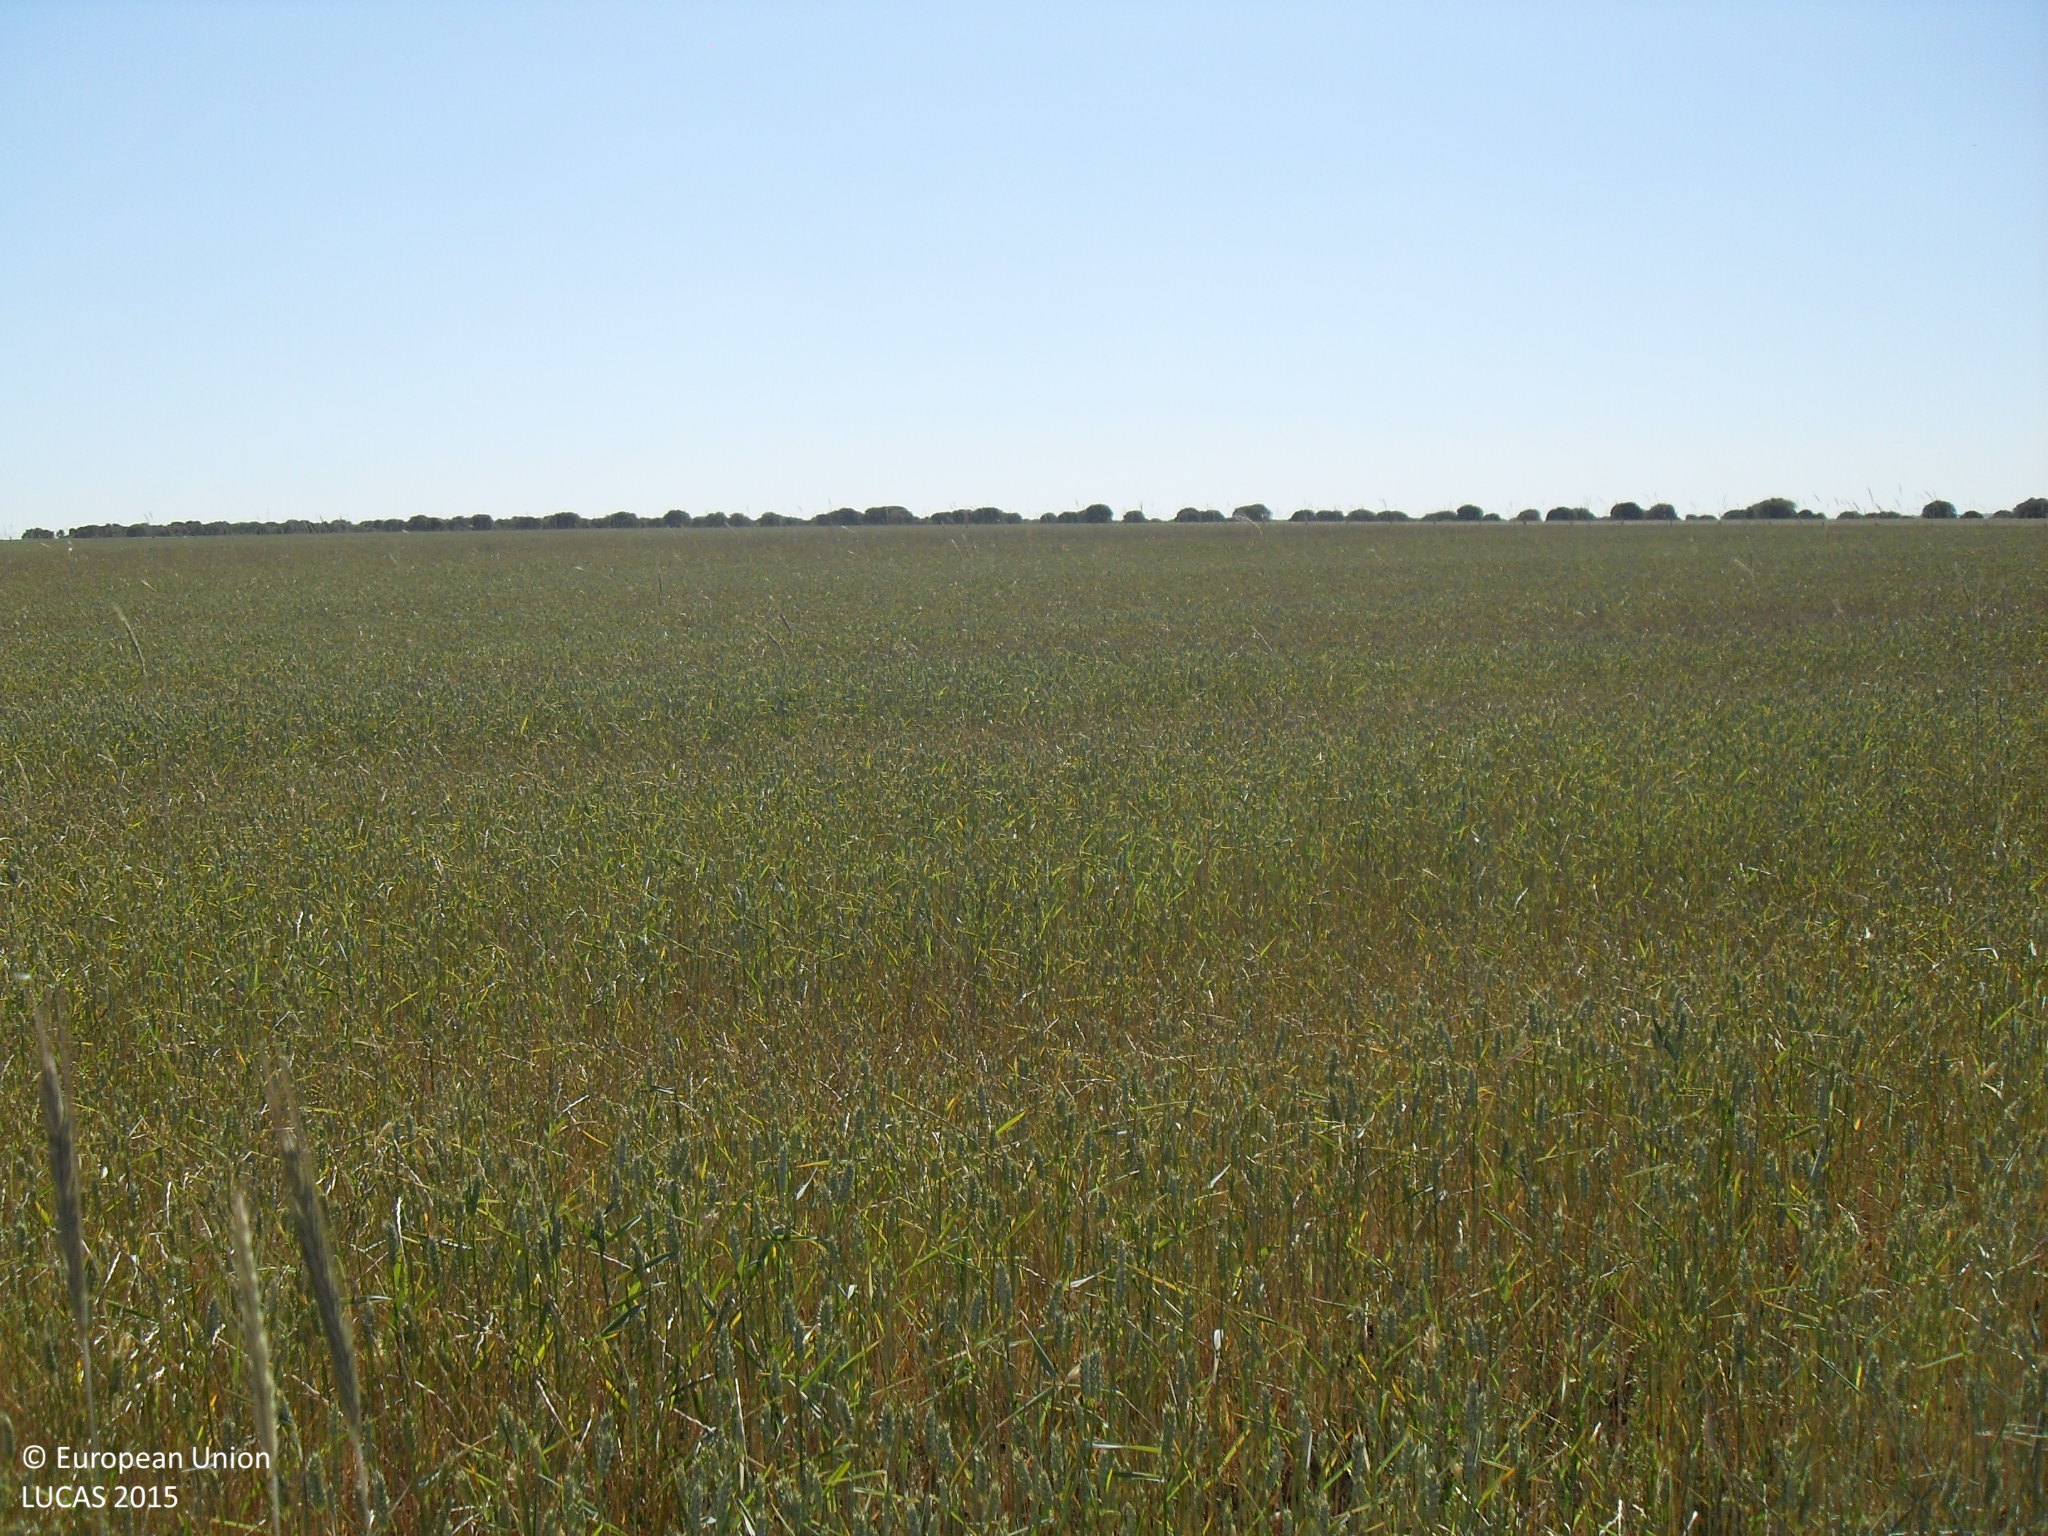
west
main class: Cropland
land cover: Common wheat
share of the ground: > 75 %
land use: Agriculture (excluding fallow land and kitchen gardens)
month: May
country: ES
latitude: 41.0945
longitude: -5.3235
